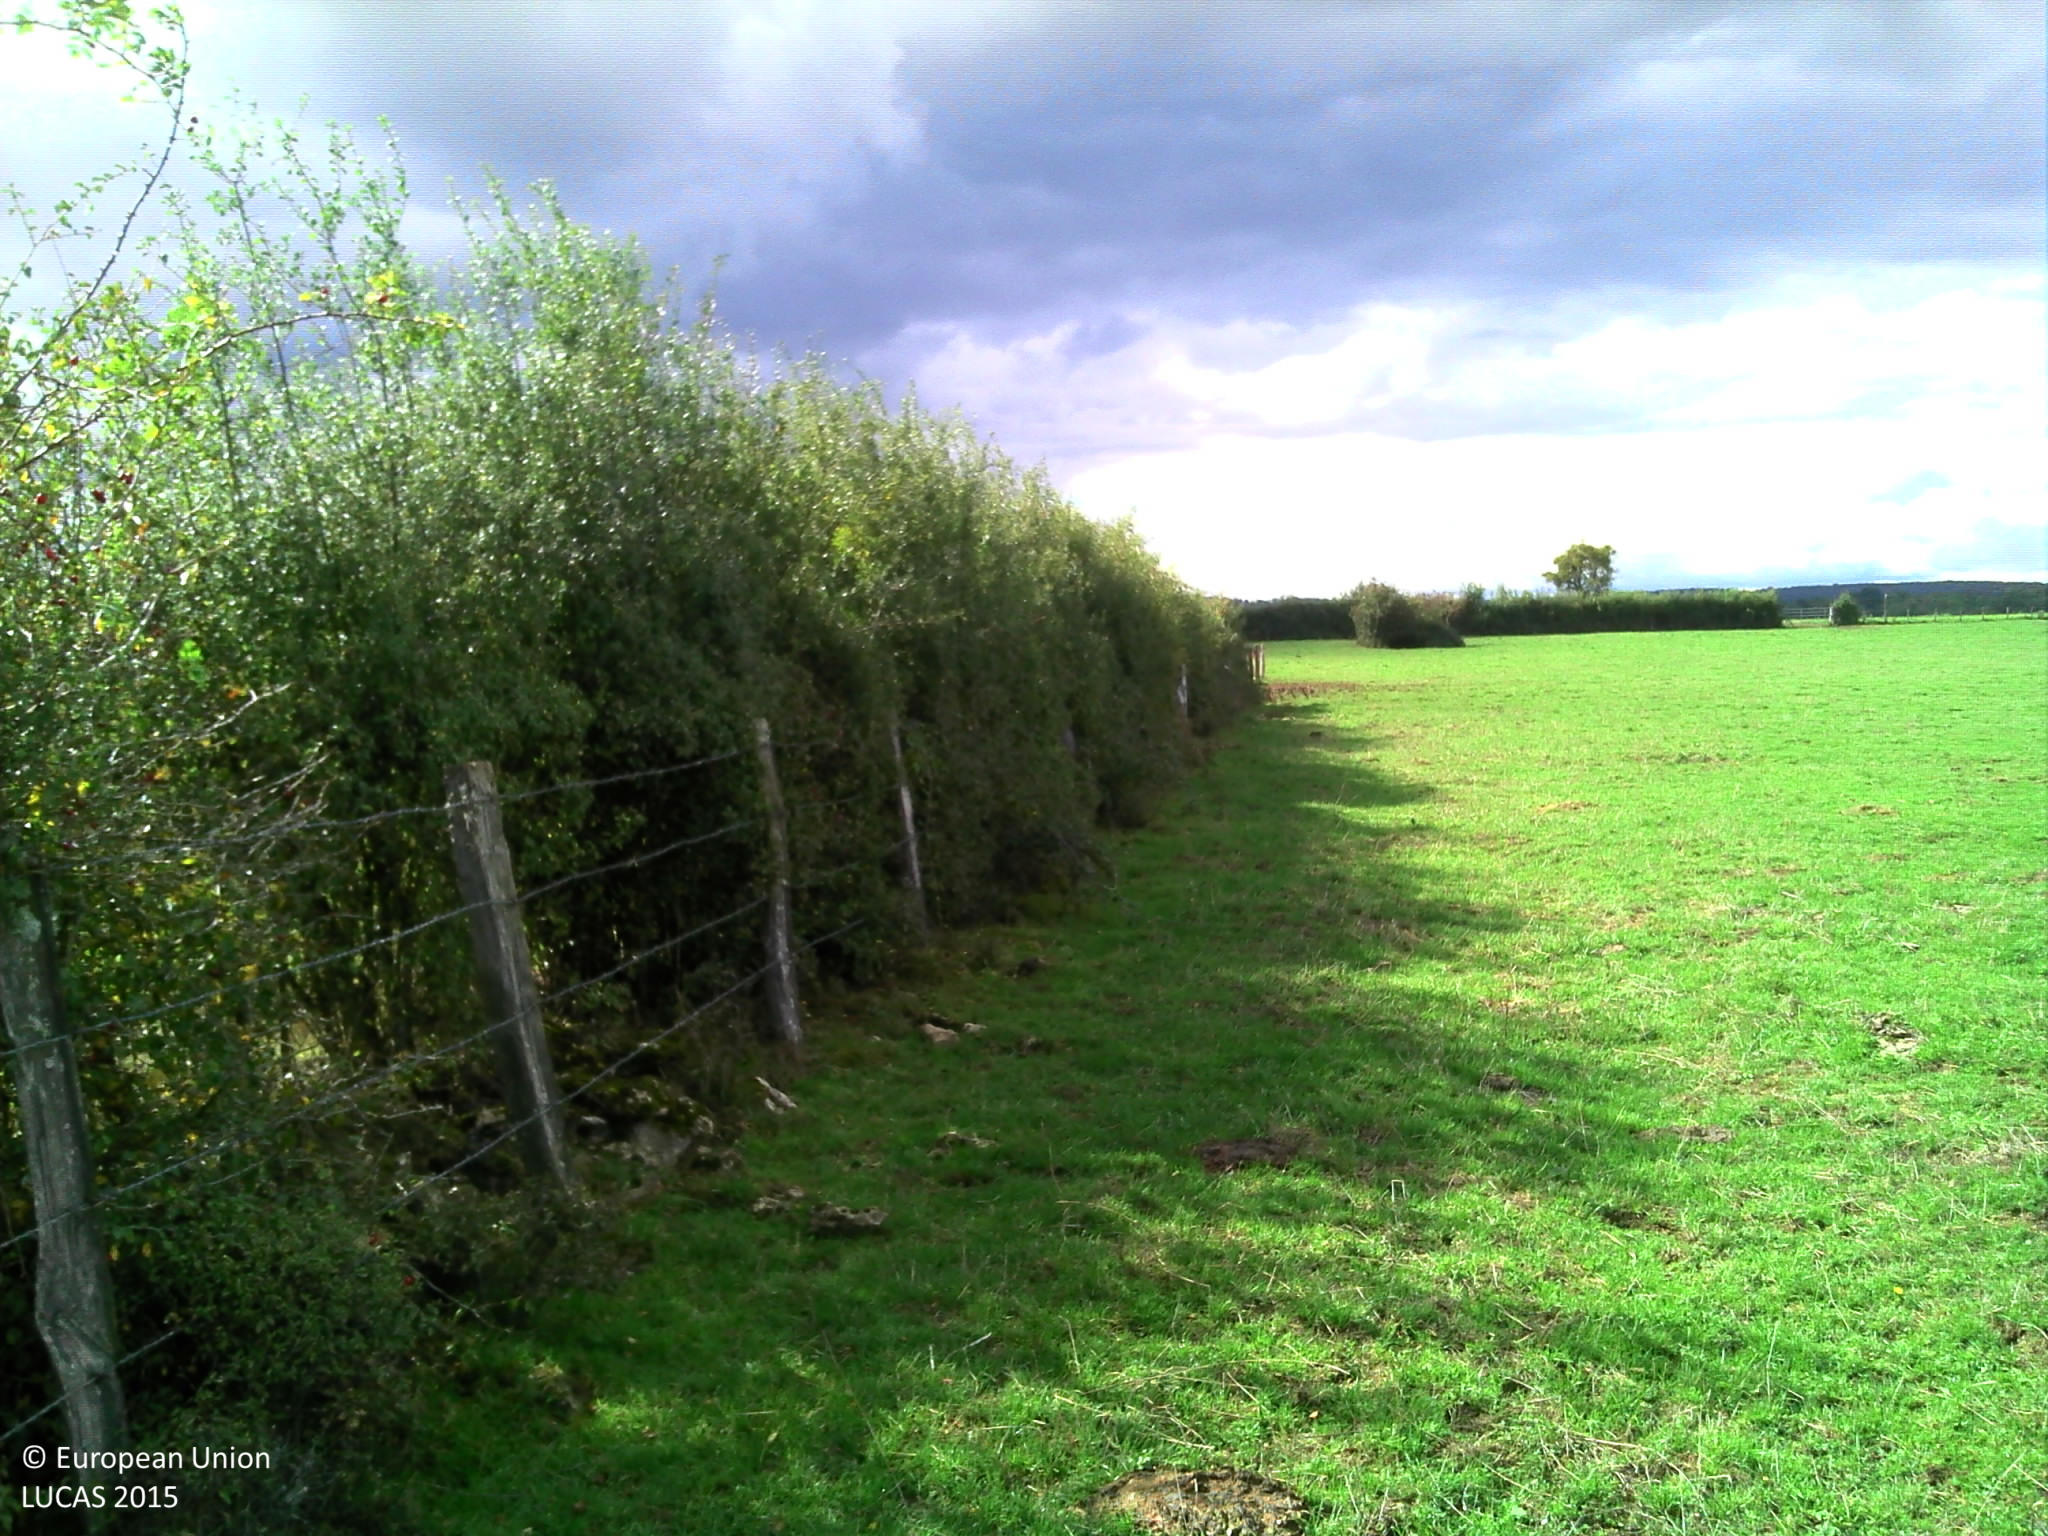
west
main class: Grassland
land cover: Grassland without tree/shrub cover
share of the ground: > 75 %
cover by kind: herbaceous plants 100 %
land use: Agriculture (excluding fallow land and kitchen gardens)
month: September
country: FR
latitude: 47.1967
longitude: 4.3897
